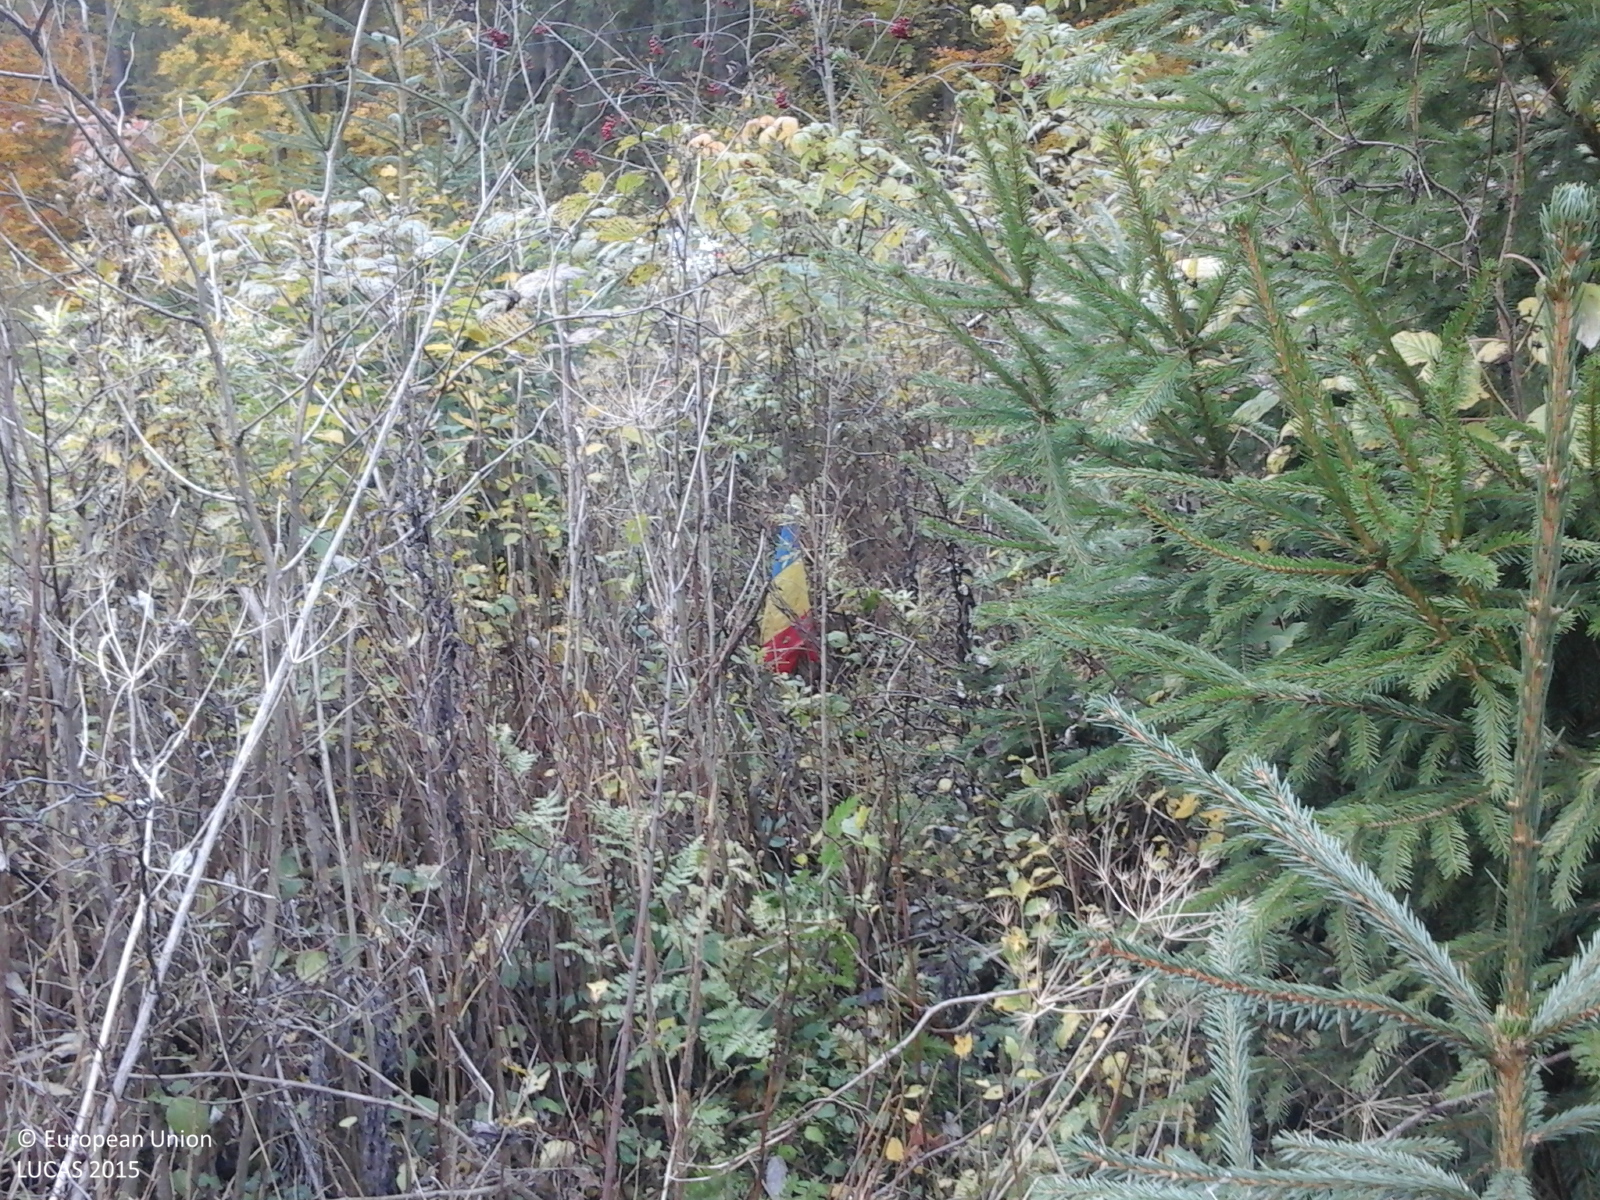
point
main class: Shrubland
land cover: Shrubland with sparse tree cover
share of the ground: > 75 %
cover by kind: shrubs 95 %, broadleaved forest trees 5 %
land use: Semi-natural and natural areas not in use
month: October
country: RO
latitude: 46.5184
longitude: 25.3428
